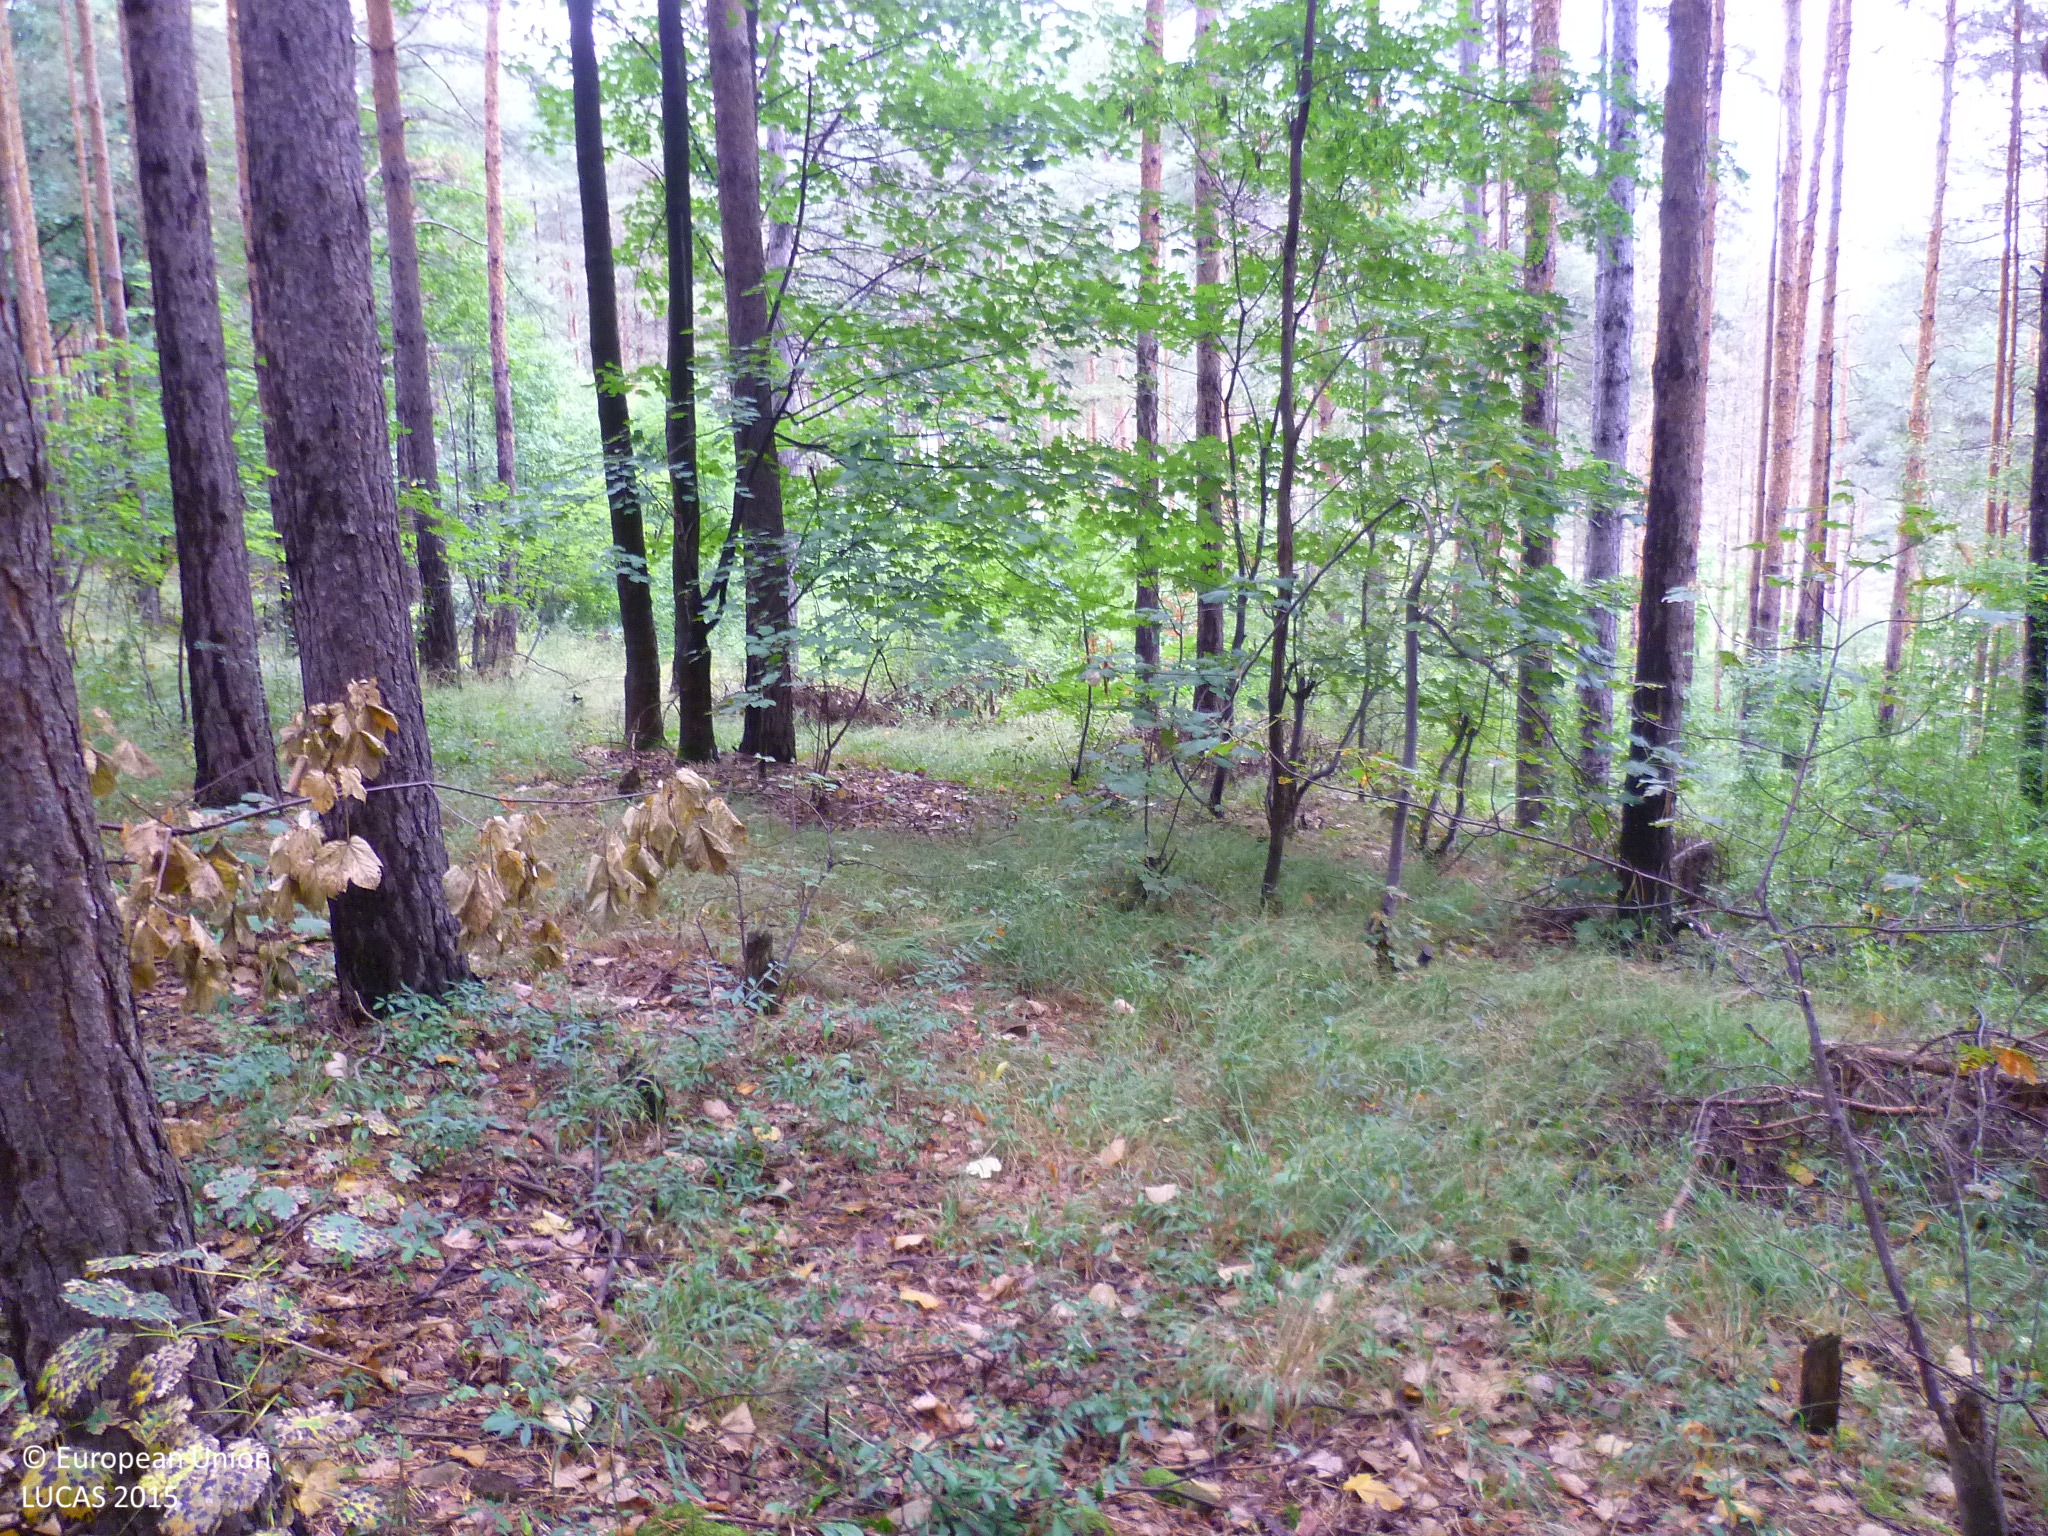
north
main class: Woodland
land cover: Pine dominated mixed woodland
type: alpine coniferous forest
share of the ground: 50 - 75 %
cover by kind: coniferous forest trees 50 %, broadleaved forest trees 30 %, unconsolidated bare surface 10 %, shrubs 5 %, herbaceous plants 5 %
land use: Forestry
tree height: > 5 m
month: September
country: BG
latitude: 42.7573
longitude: 22.8953
